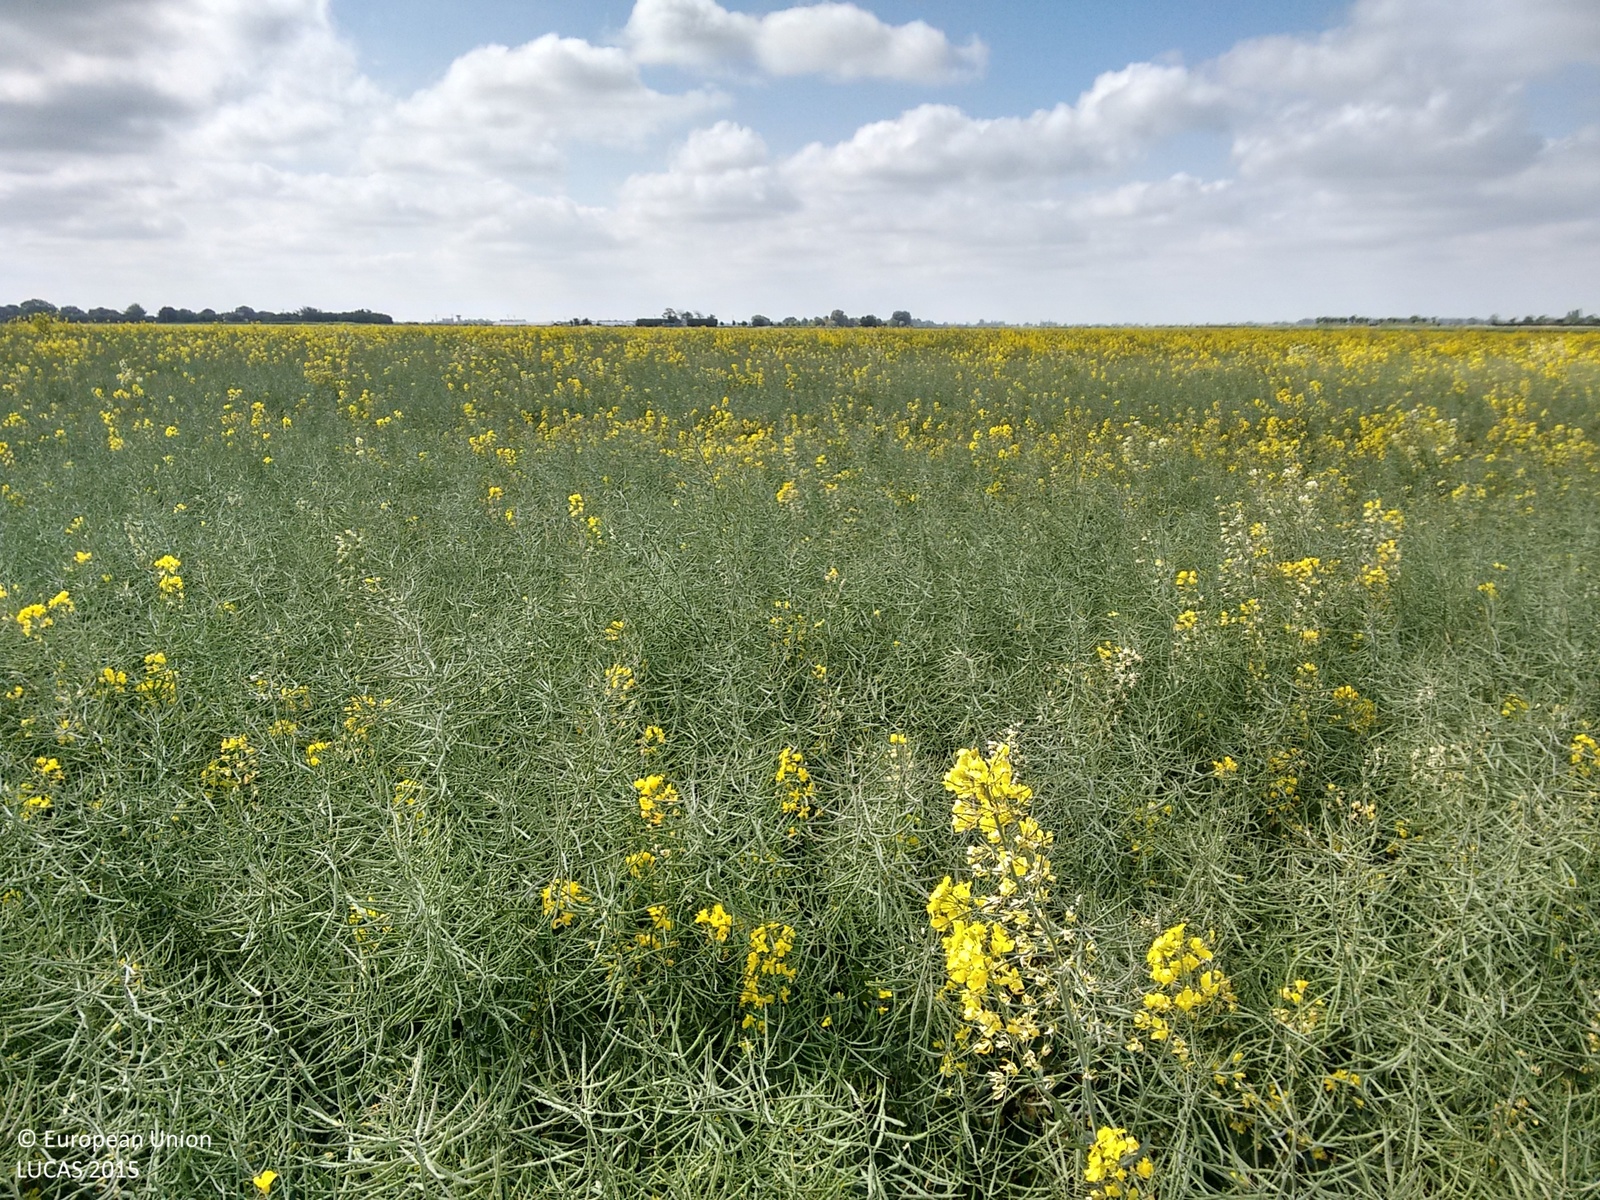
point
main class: Cropland
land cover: Rape and turnip rape
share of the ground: > 75 %
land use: Agriculture (excluding fallow land and kitchen gardens)
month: May
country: GB
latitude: 52.7462
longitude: -0.0620
